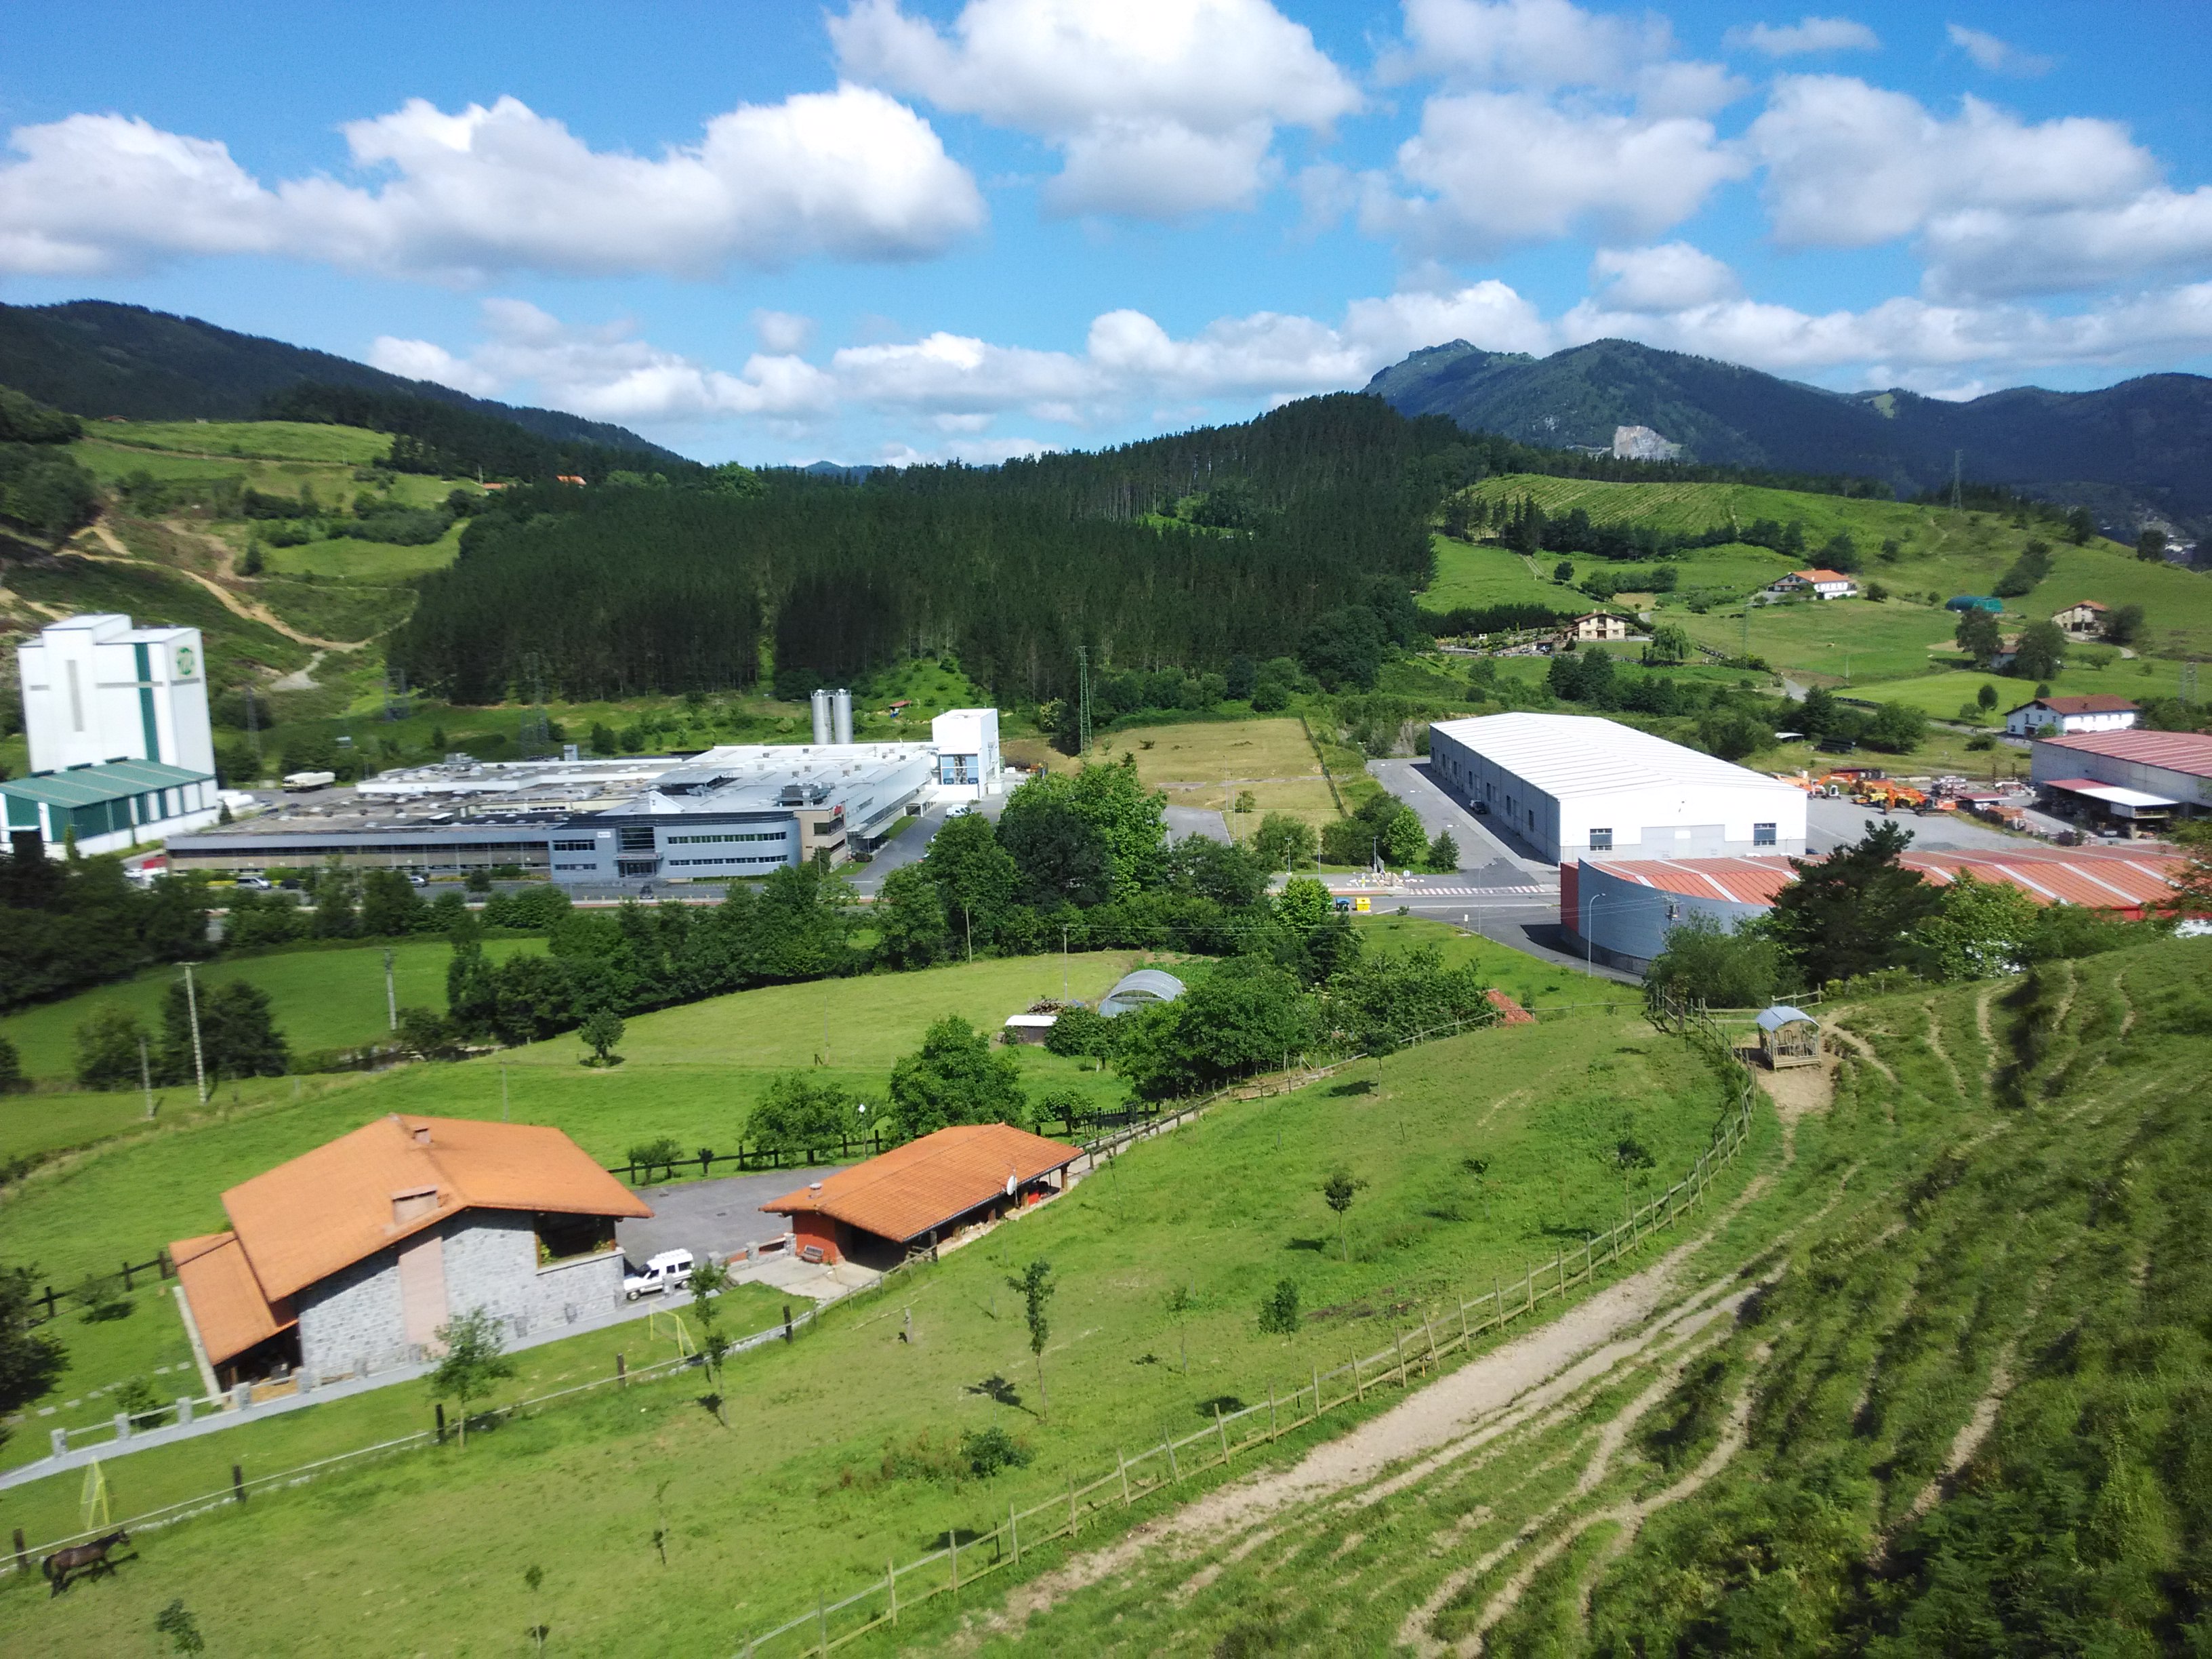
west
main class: Grassland
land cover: Grassland without tree/shrub cover
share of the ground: > 75 %
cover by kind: herbaceous plants 100 %
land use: Agriculture (excluding fallow land and kitchen gardens)
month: June
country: ES
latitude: 43.2474
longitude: -2.4797
